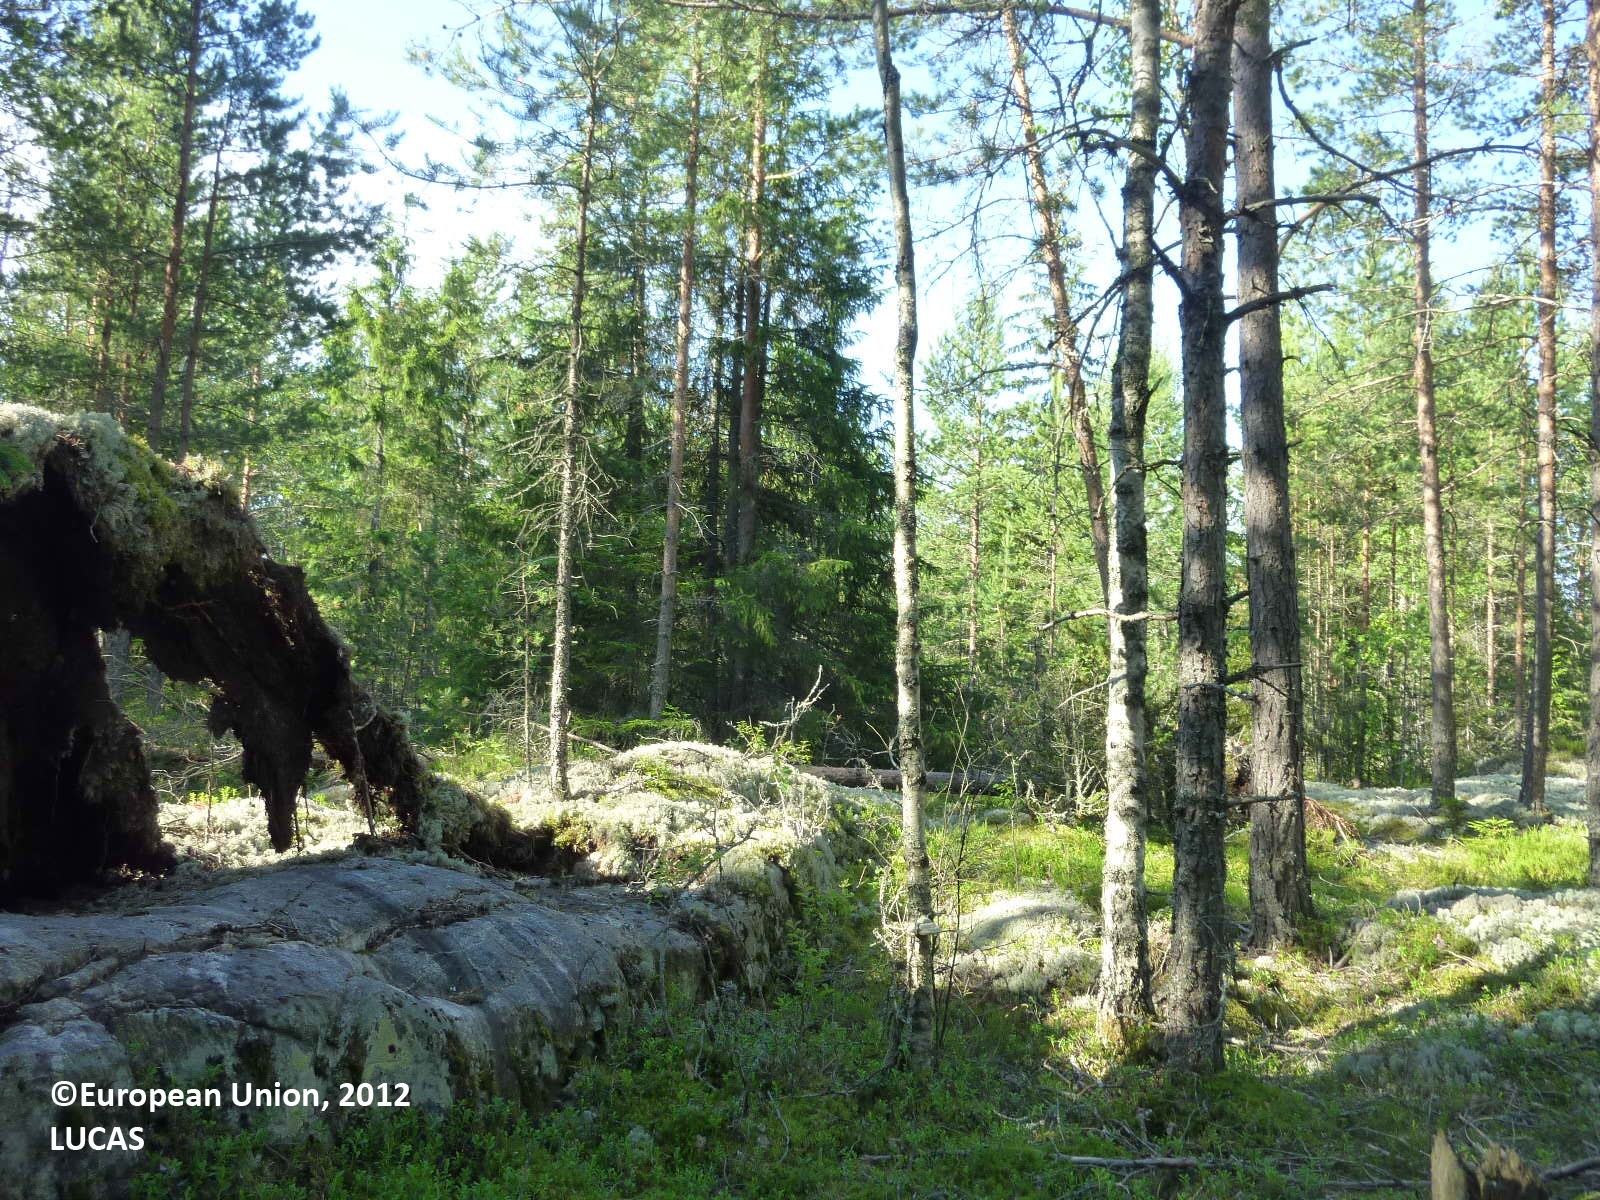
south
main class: Woodland
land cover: Pine dominated mixed woodland
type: boreal forest
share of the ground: 25 - 50 %
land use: Forestry
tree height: > 5 m
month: July
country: FI
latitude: 61.1680
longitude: 22.5773
